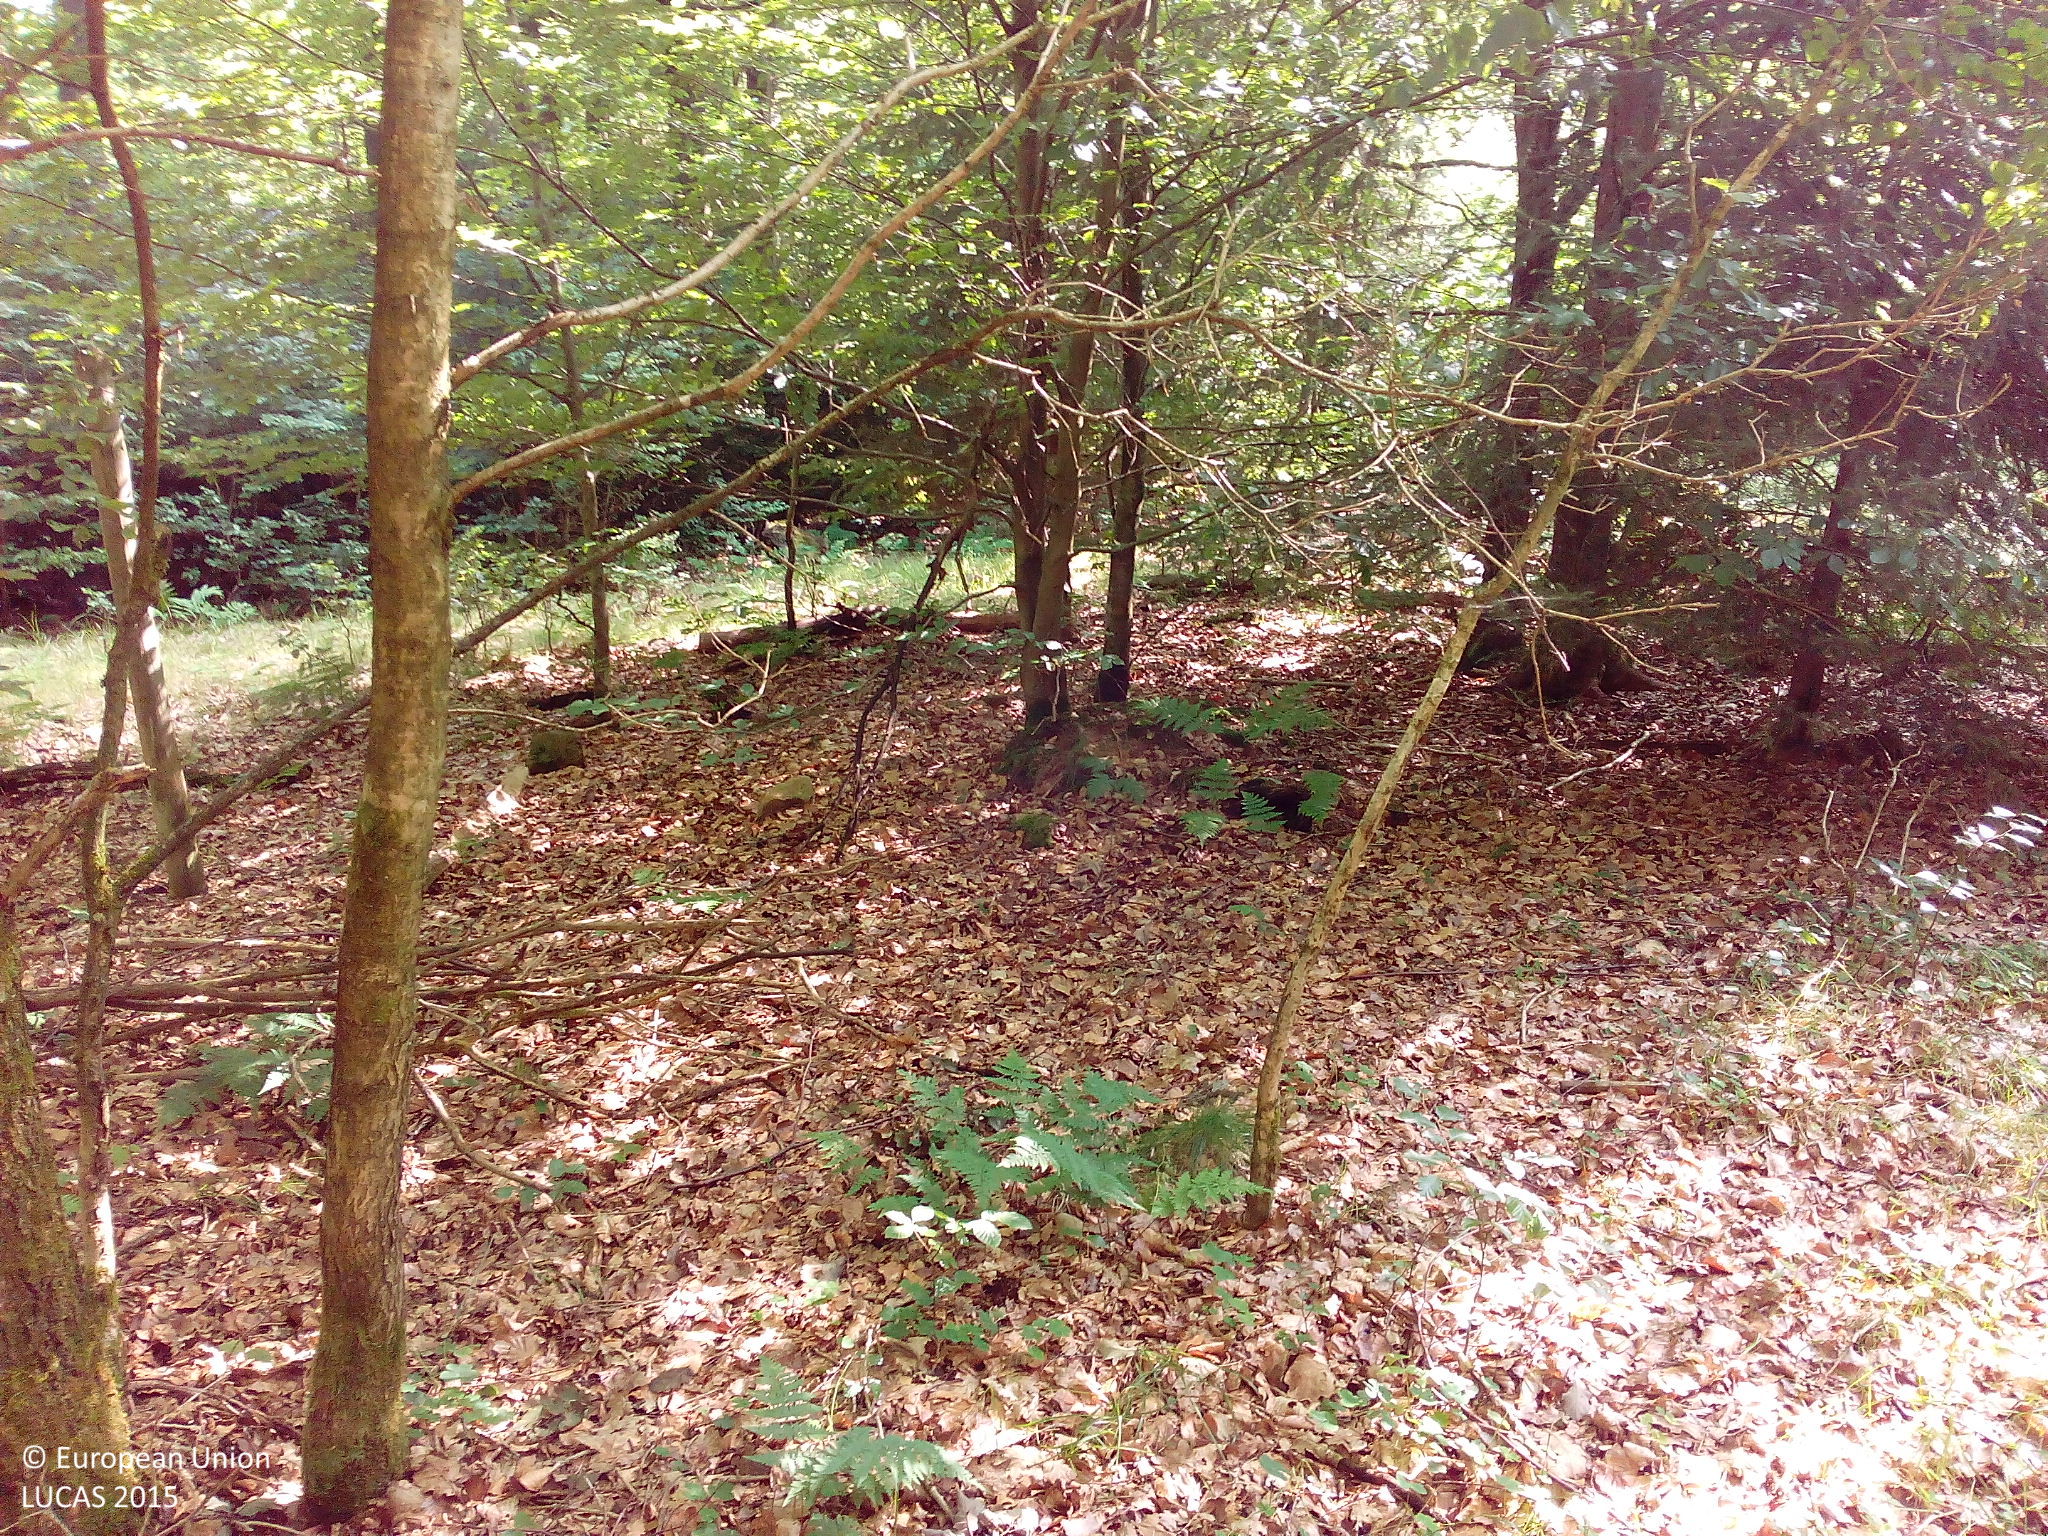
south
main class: Woodland
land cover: Spruce dominated mixed woodland
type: hemiboreal forest and nemoral coniferous forest and mixed broadleaved-coniferous forest
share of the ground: > 75 %
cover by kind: coniferous forest trees 60 %, broadleaved forest trees 40 %
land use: Forestry
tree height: > 5 m
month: July
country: DE
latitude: 50.6157
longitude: 9.8728
